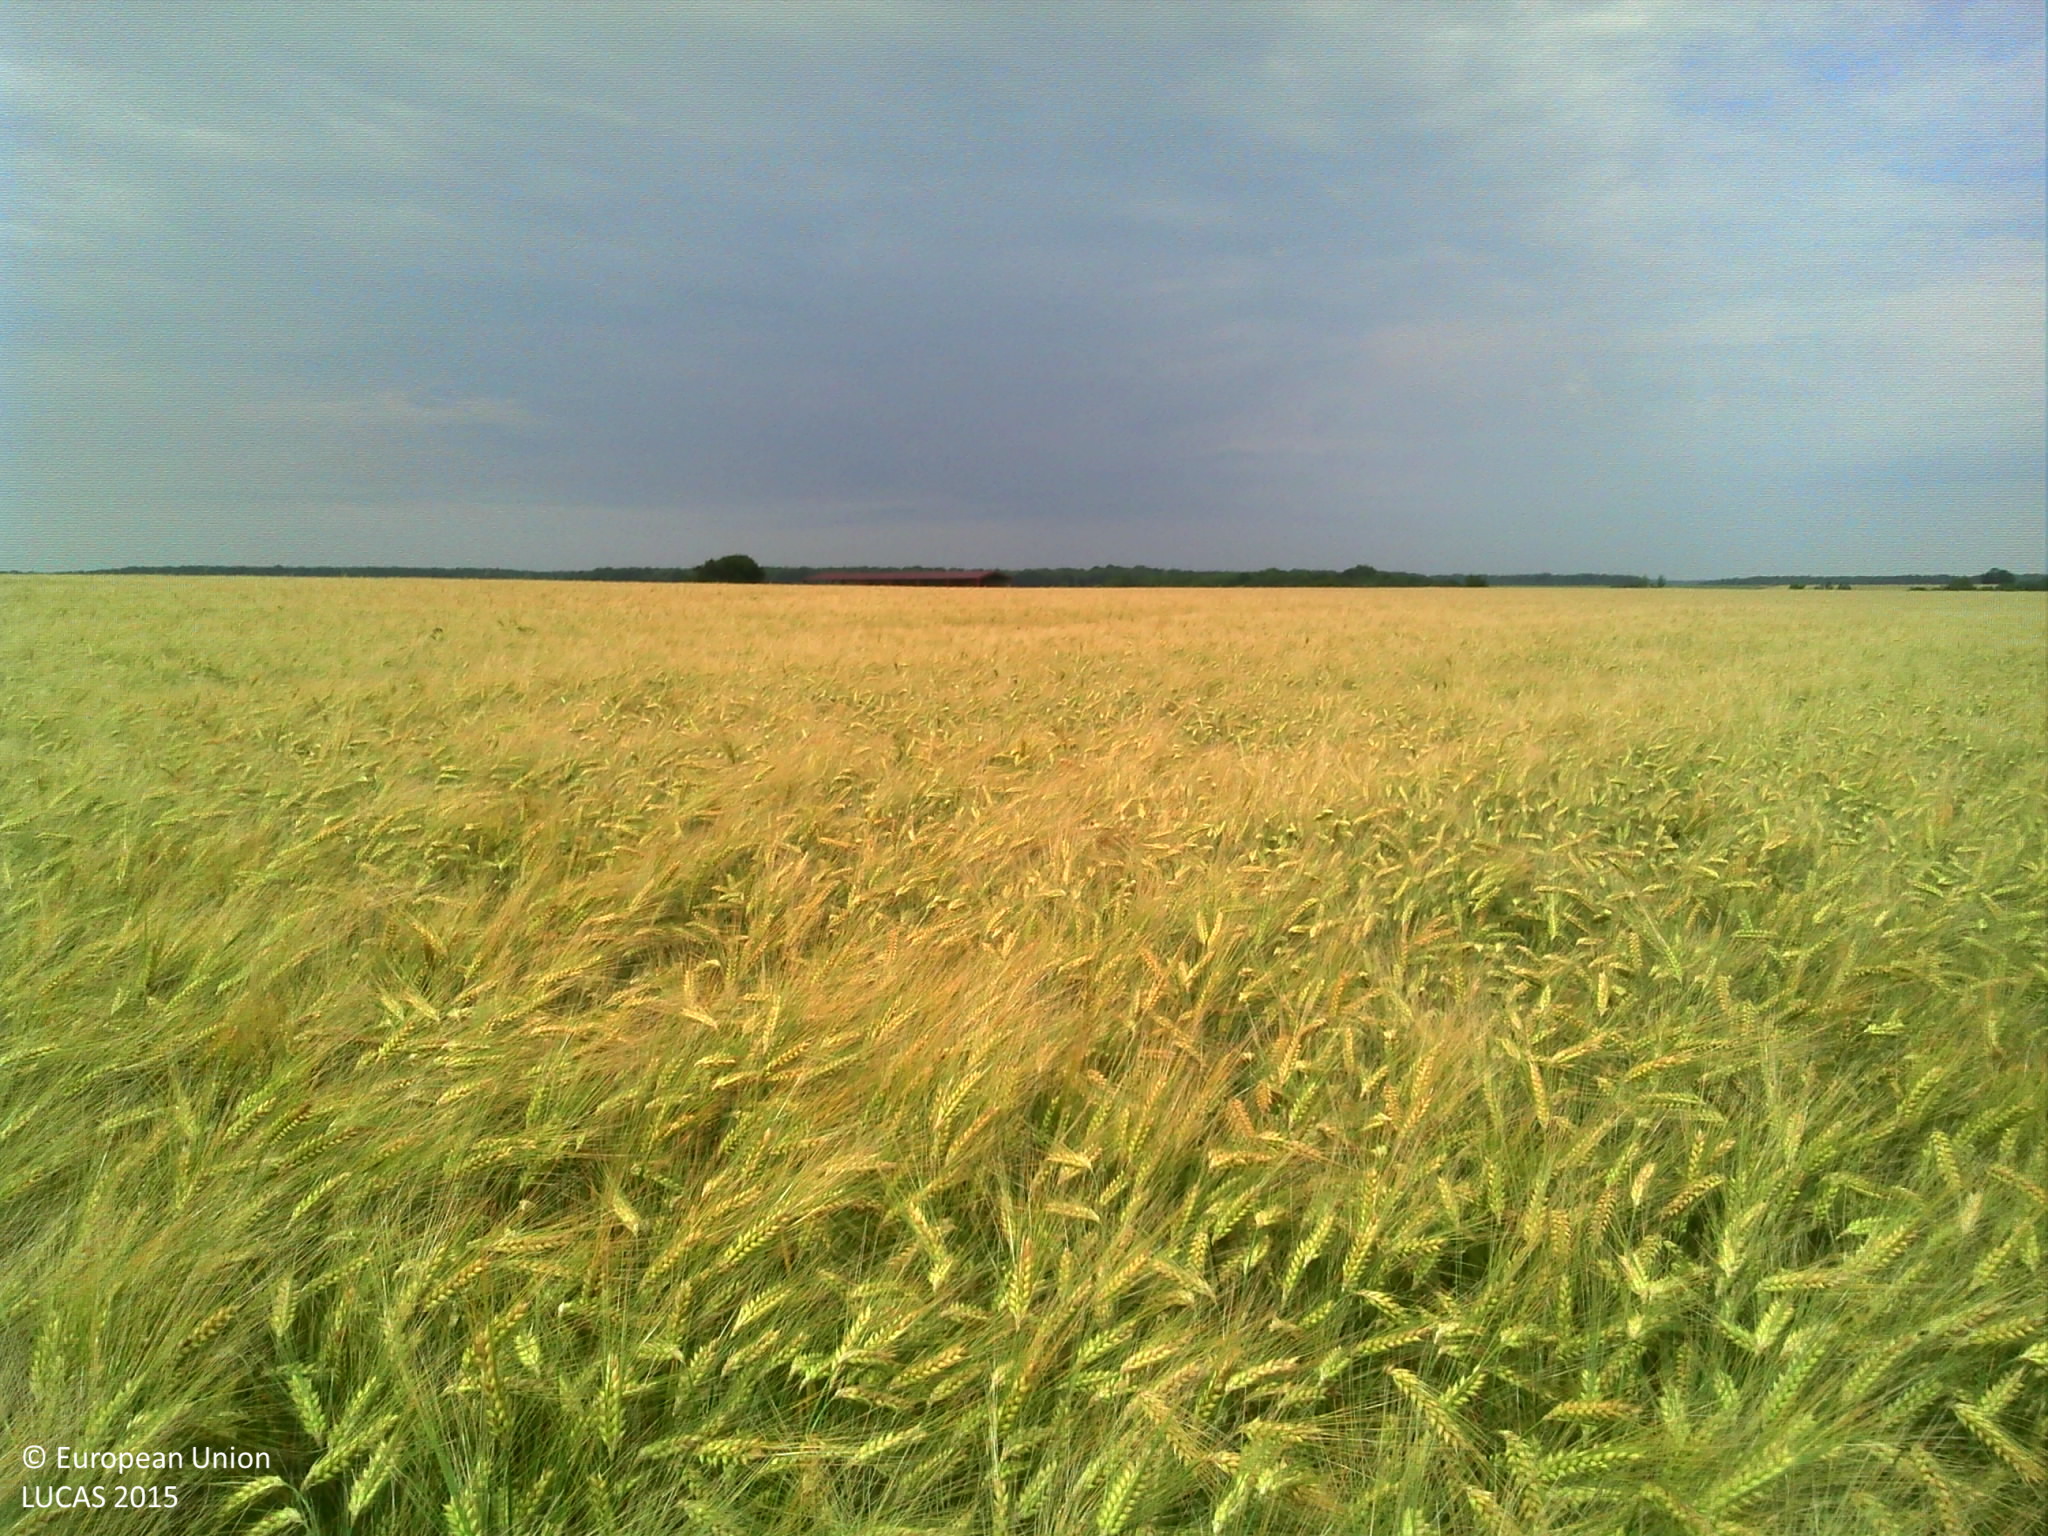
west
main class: Cropland
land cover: Barley
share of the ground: > 75 %
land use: Agriculture (excluding fallow land and kitchen gardens)
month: June
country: FR
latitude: 48.3956
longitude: 4.9337
